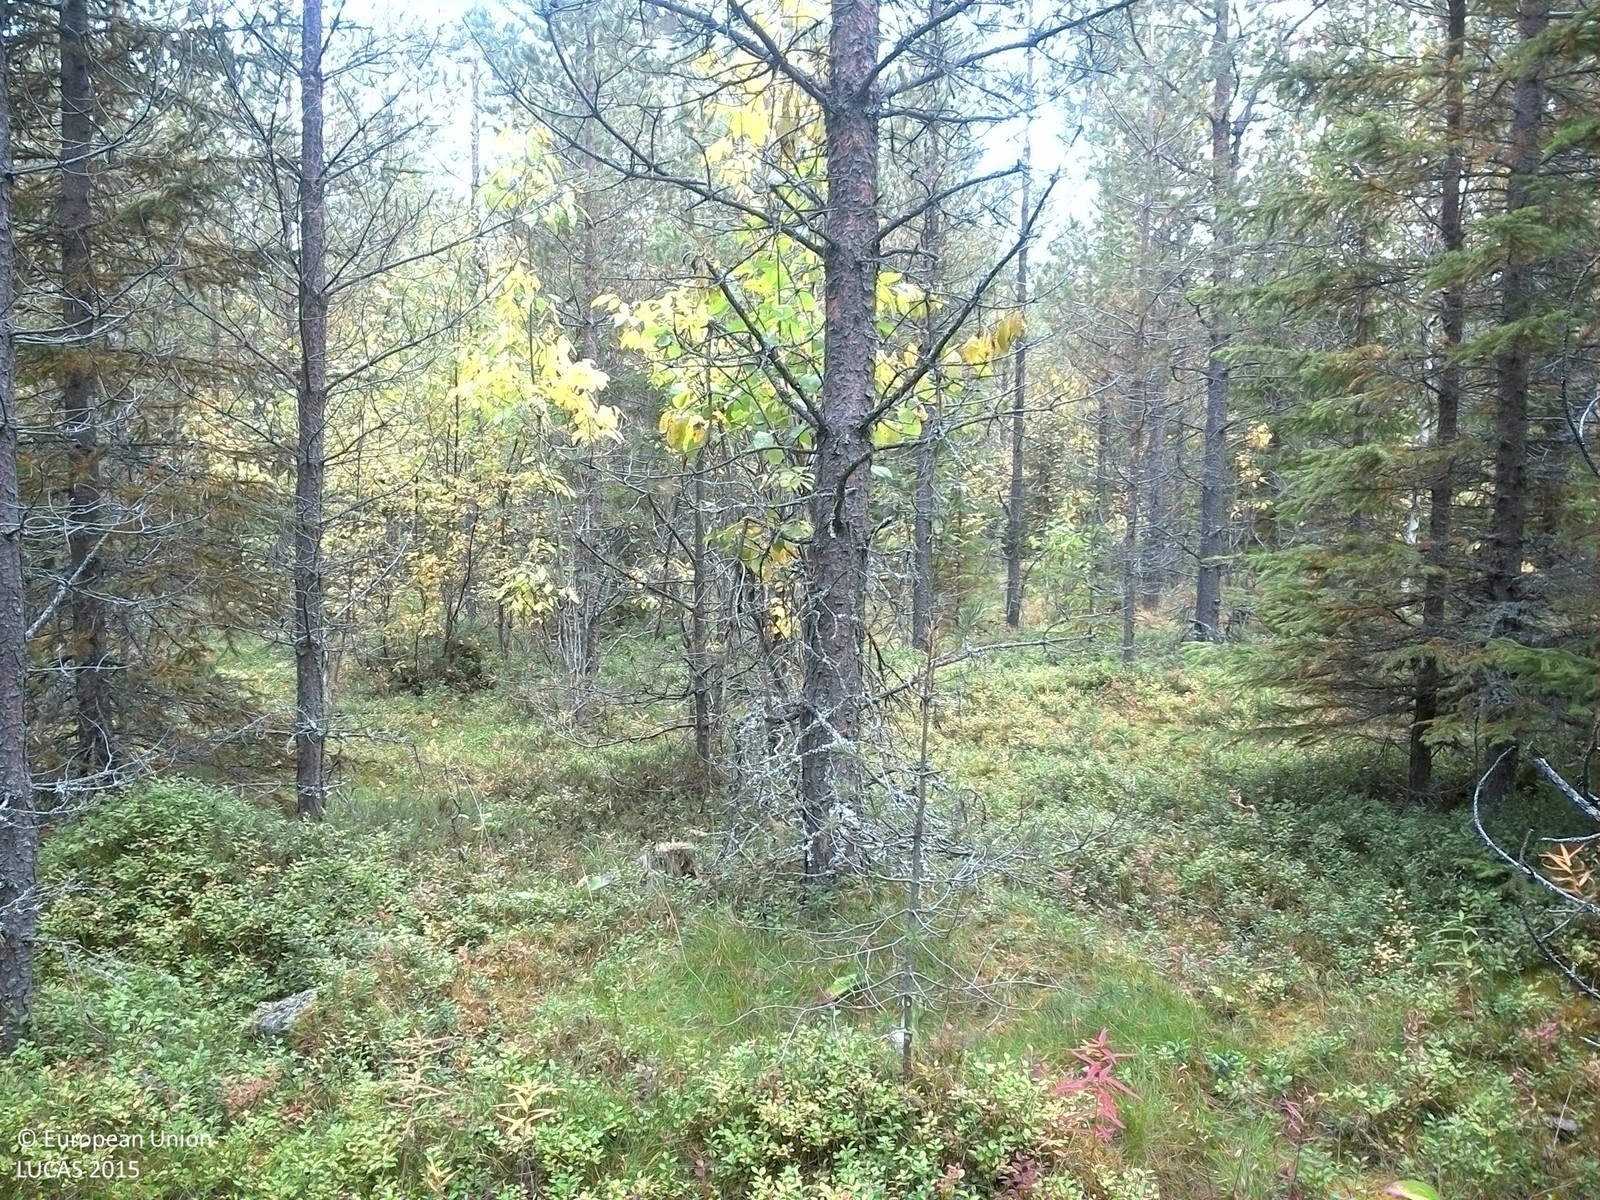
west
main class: Woodland
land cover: Pine dominated mixed woodland
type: boreal forest
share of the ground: 50 - 75 %
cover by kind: coniferous forest trees 45 %, shrubs 25 %, broadleaved forest trees 15 %, lichens and mosses 10 %, herbaceous plants 5 %
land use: Forestry
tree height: > 5 m
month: September
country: SE
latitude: 63.6067
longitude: 16.2038
